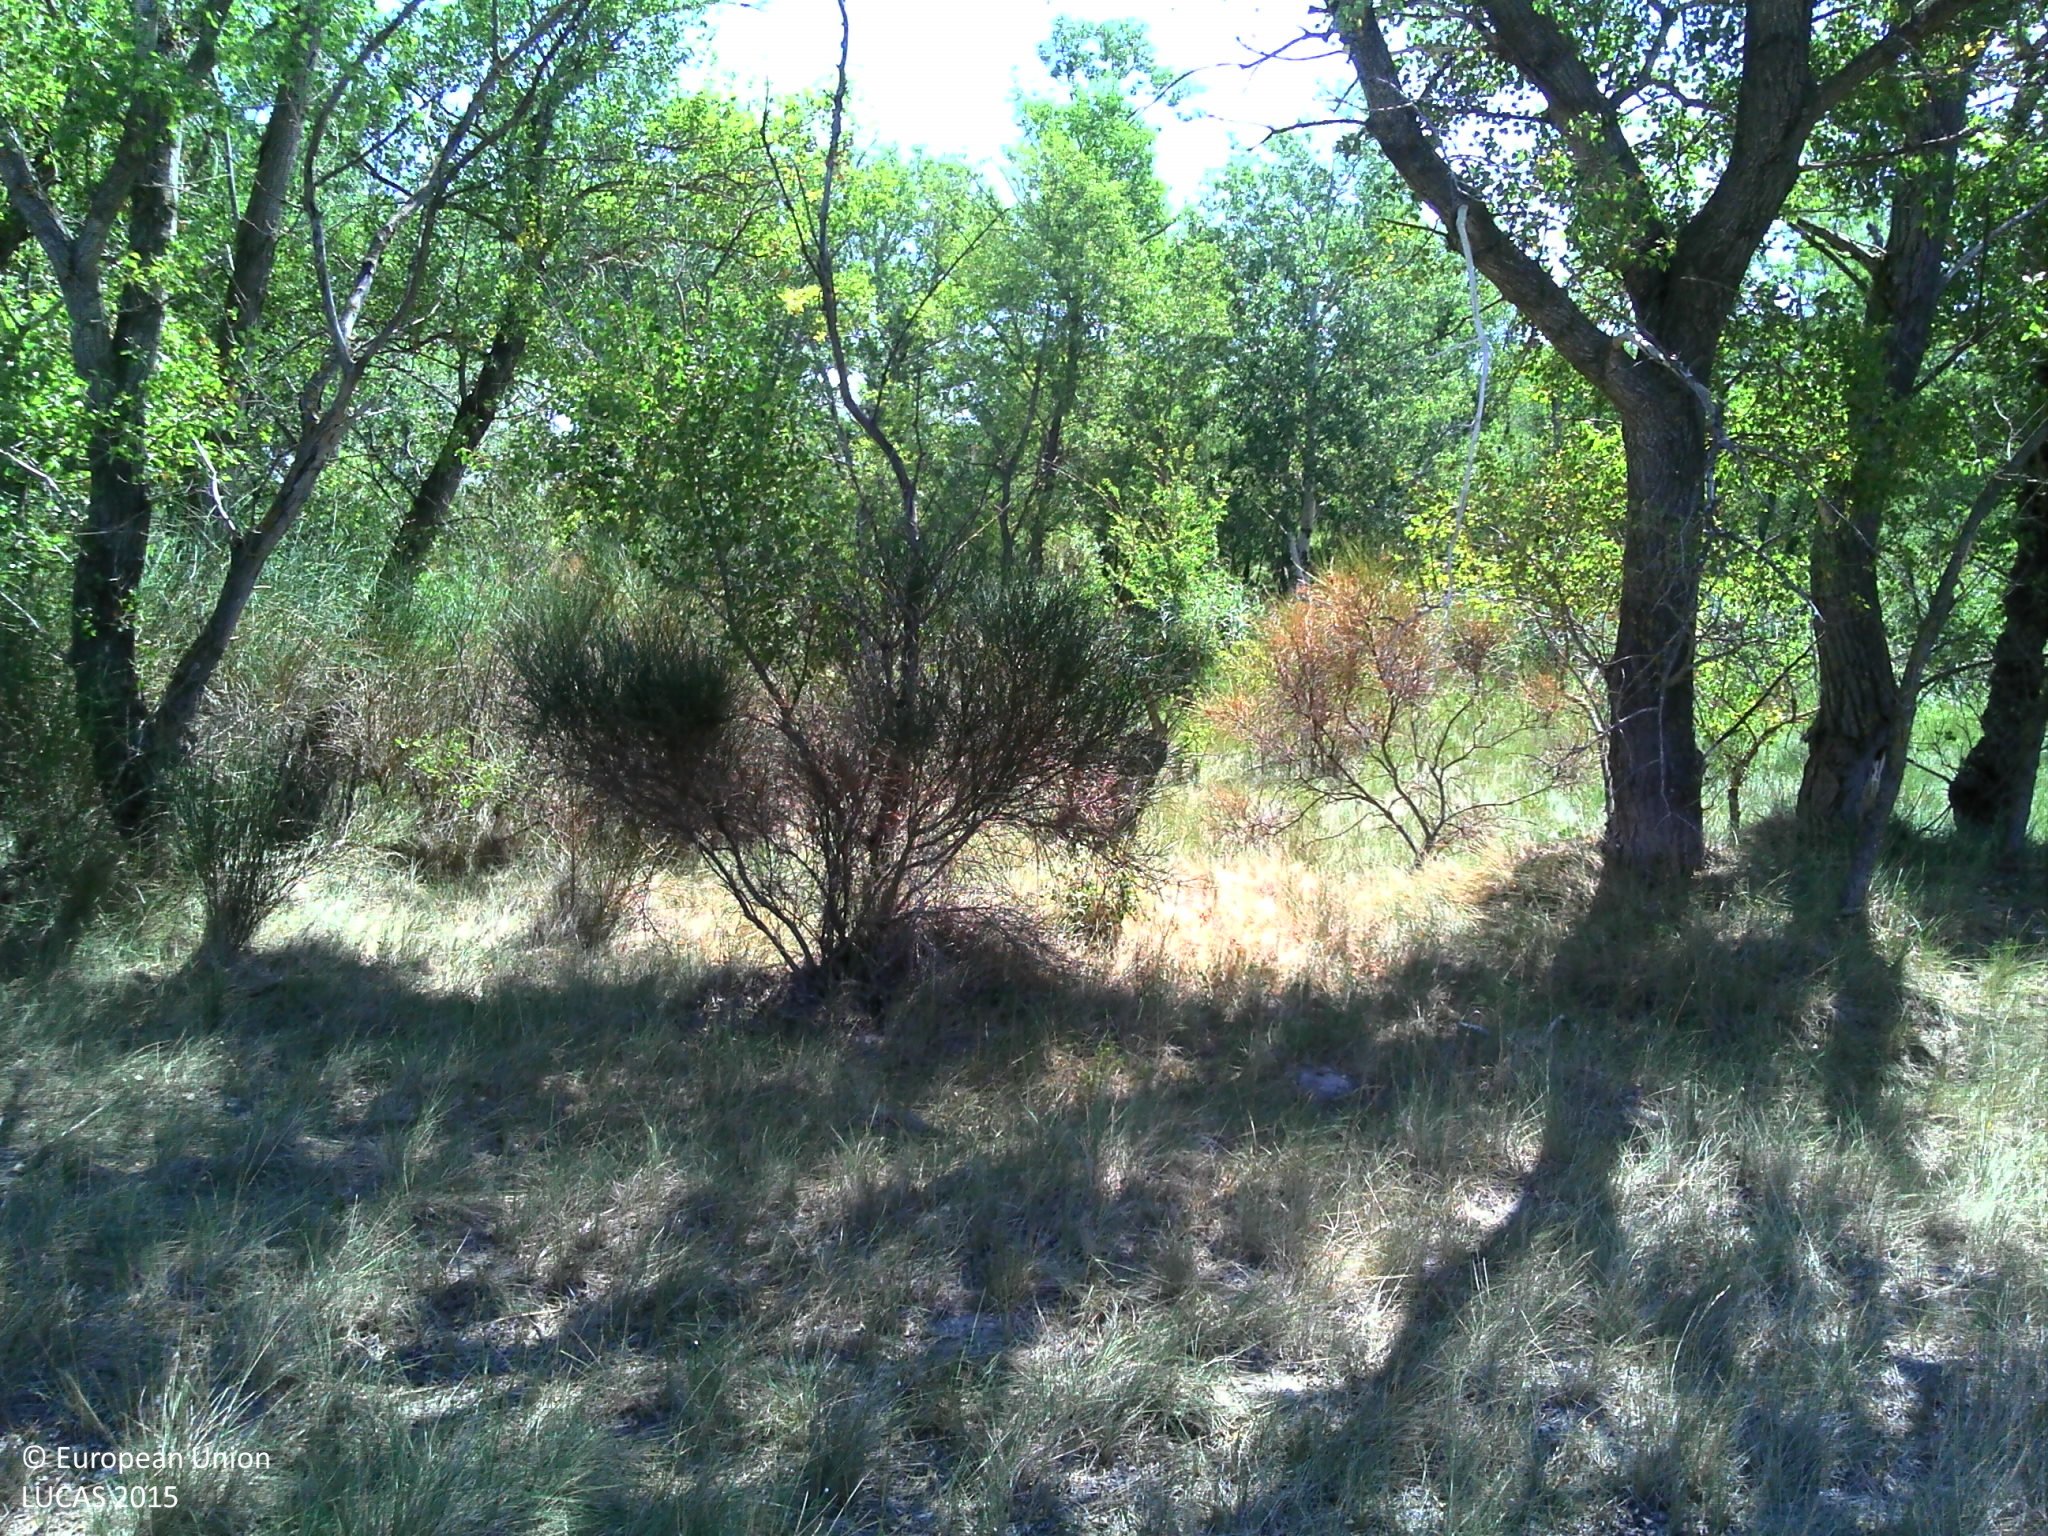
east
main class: Woodland
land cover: Broadleaved woodland
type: hemiboreal forest and nemoral coniferous forest and mixed broadleaved-coniferous forest
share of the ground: > 75 %
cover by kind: broadleaved forest trees 45 %, herbaceous plants 25 %, shrubs 20 %, unconsolidated bare surface 10 %
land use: Semi-natural and natural areas not in use
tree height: < 5 m
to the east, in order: Broadleaved woodland; Rivers and streams; Broadleaved woodland; Shrubland with sparse tree cover; Broadleaved woodland
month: July
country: FR
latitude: 43.7495
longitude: 5.1534
